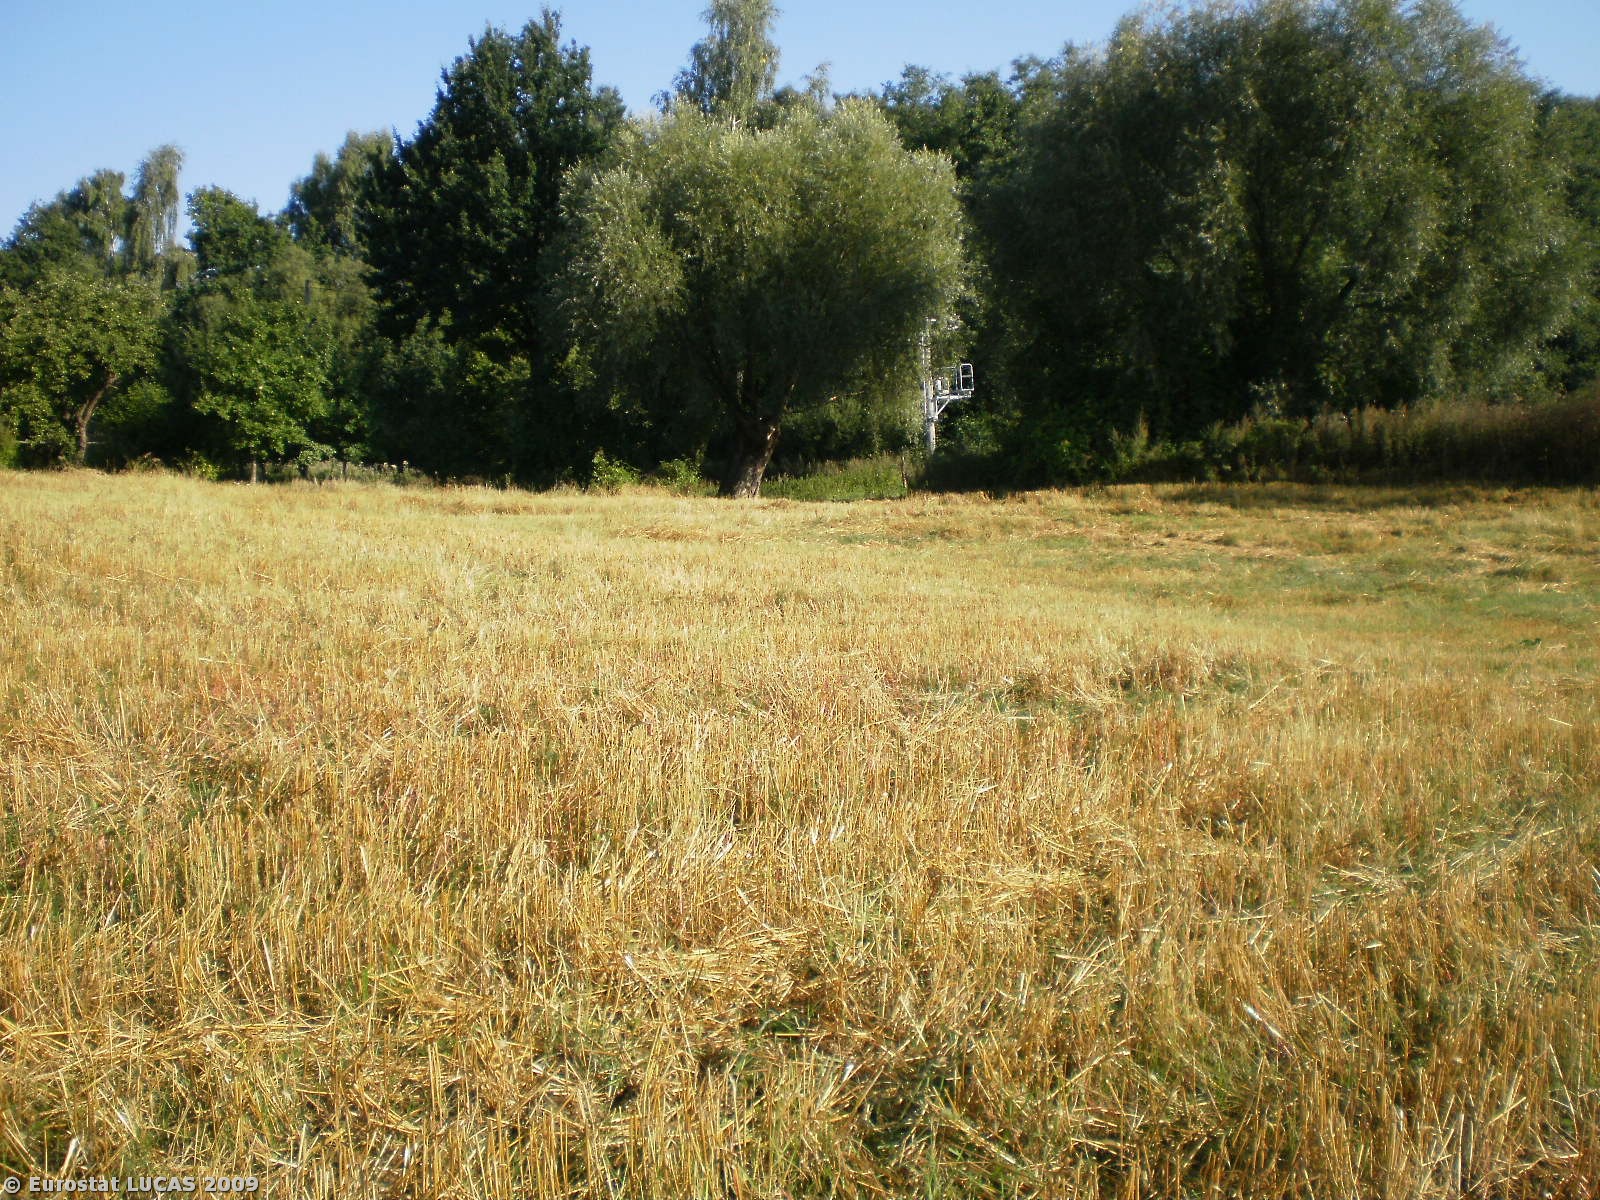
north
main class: Cropland
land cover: Oats
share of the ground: < 10 %
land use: Agriculture (excluding fallow land and kitchen gardens)
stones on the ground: < 10 %
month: September
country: PL
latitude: 53.8877
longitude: 22.0622
